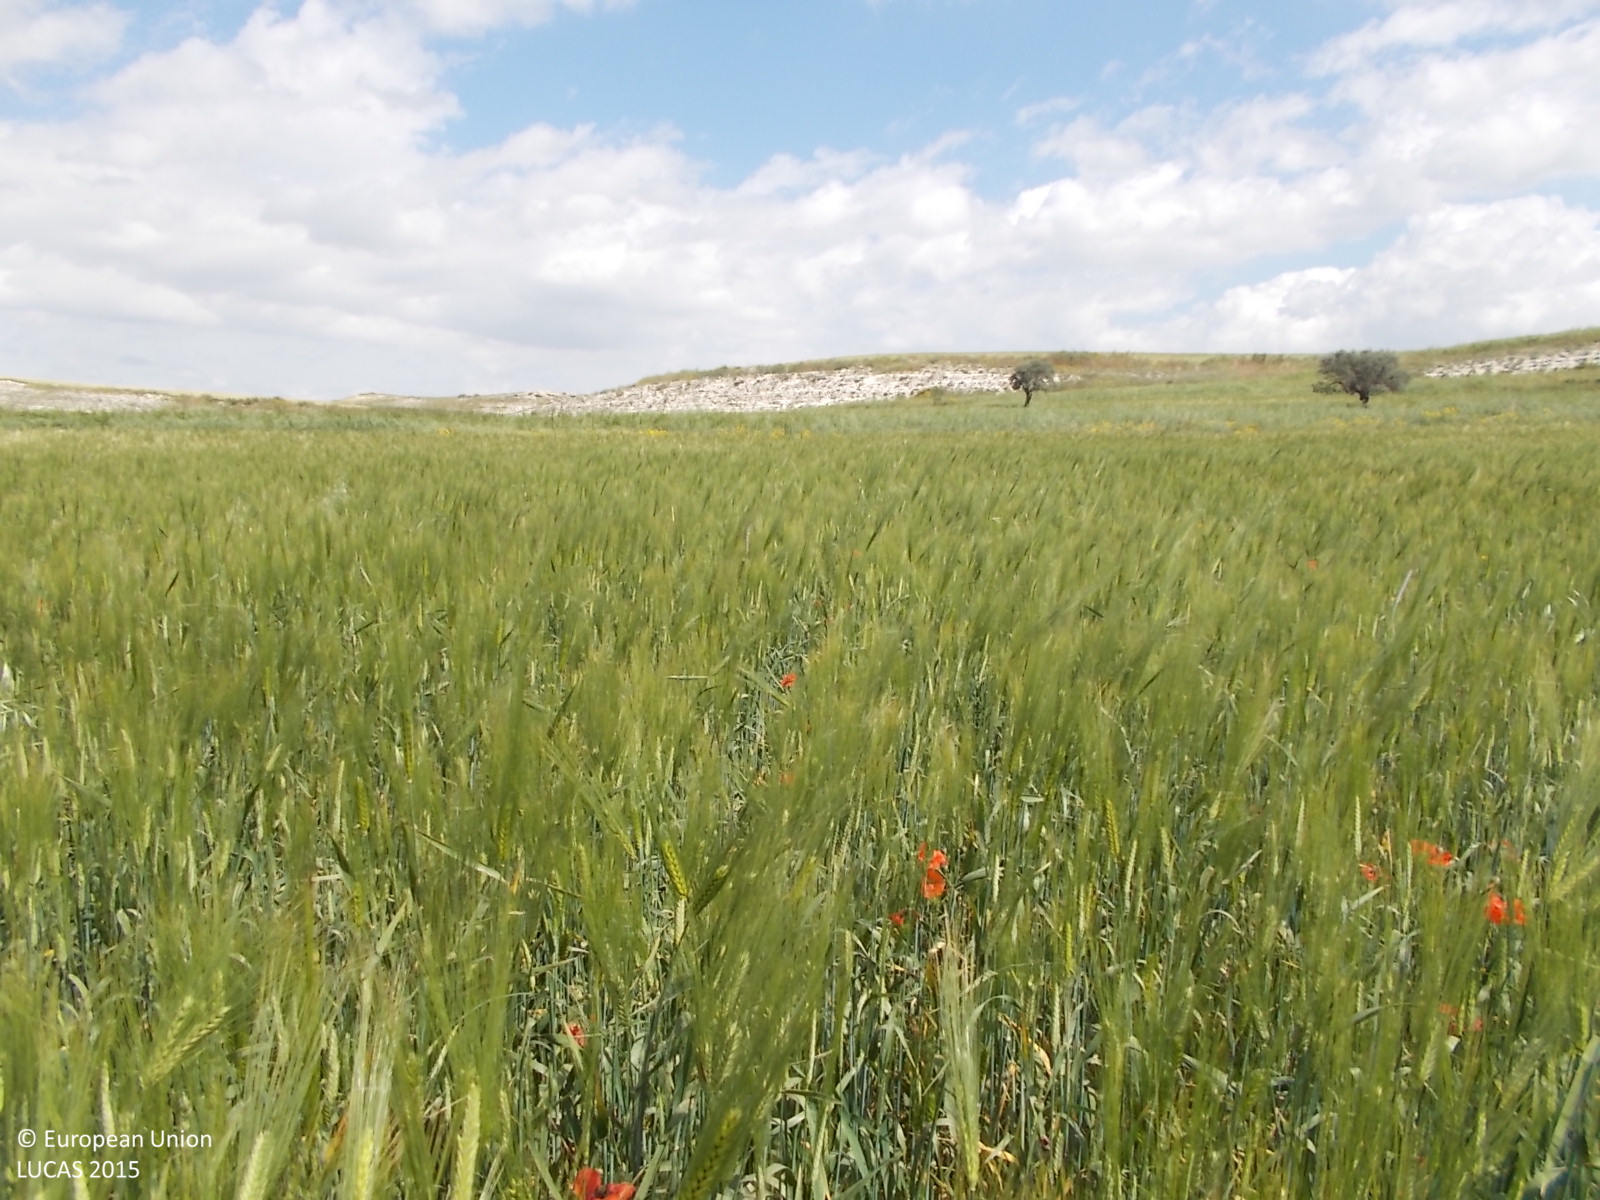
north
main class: Cropland
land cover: Barley
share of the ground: > 75 %
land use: Agriculture (excluding fallow land and kitchen gardens)
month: April
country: CY
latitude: 35.0372
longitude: 33.5112
